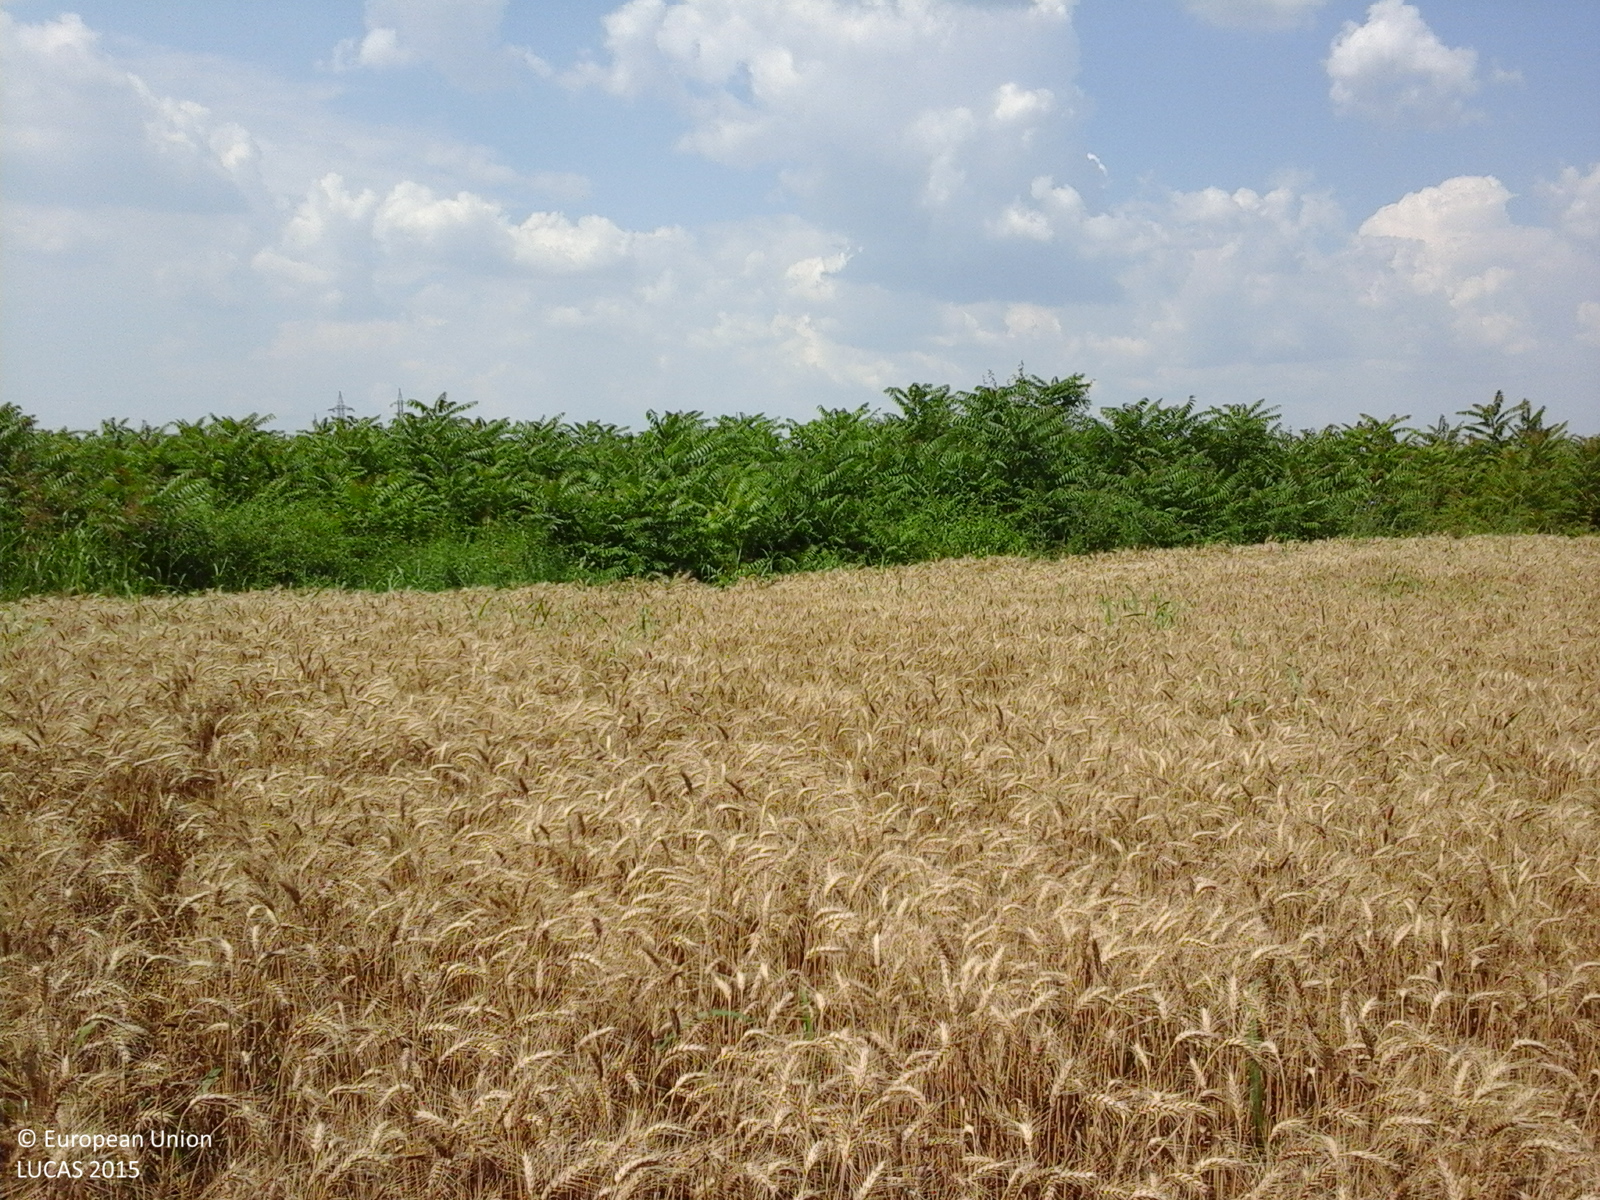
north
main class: Cropland
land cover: Common wheat
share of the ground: > 75 %
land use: Agriculture (excluding fallow land and kitchen gardens)
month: July
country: RO
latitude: 43.6698
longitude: 25.3980
